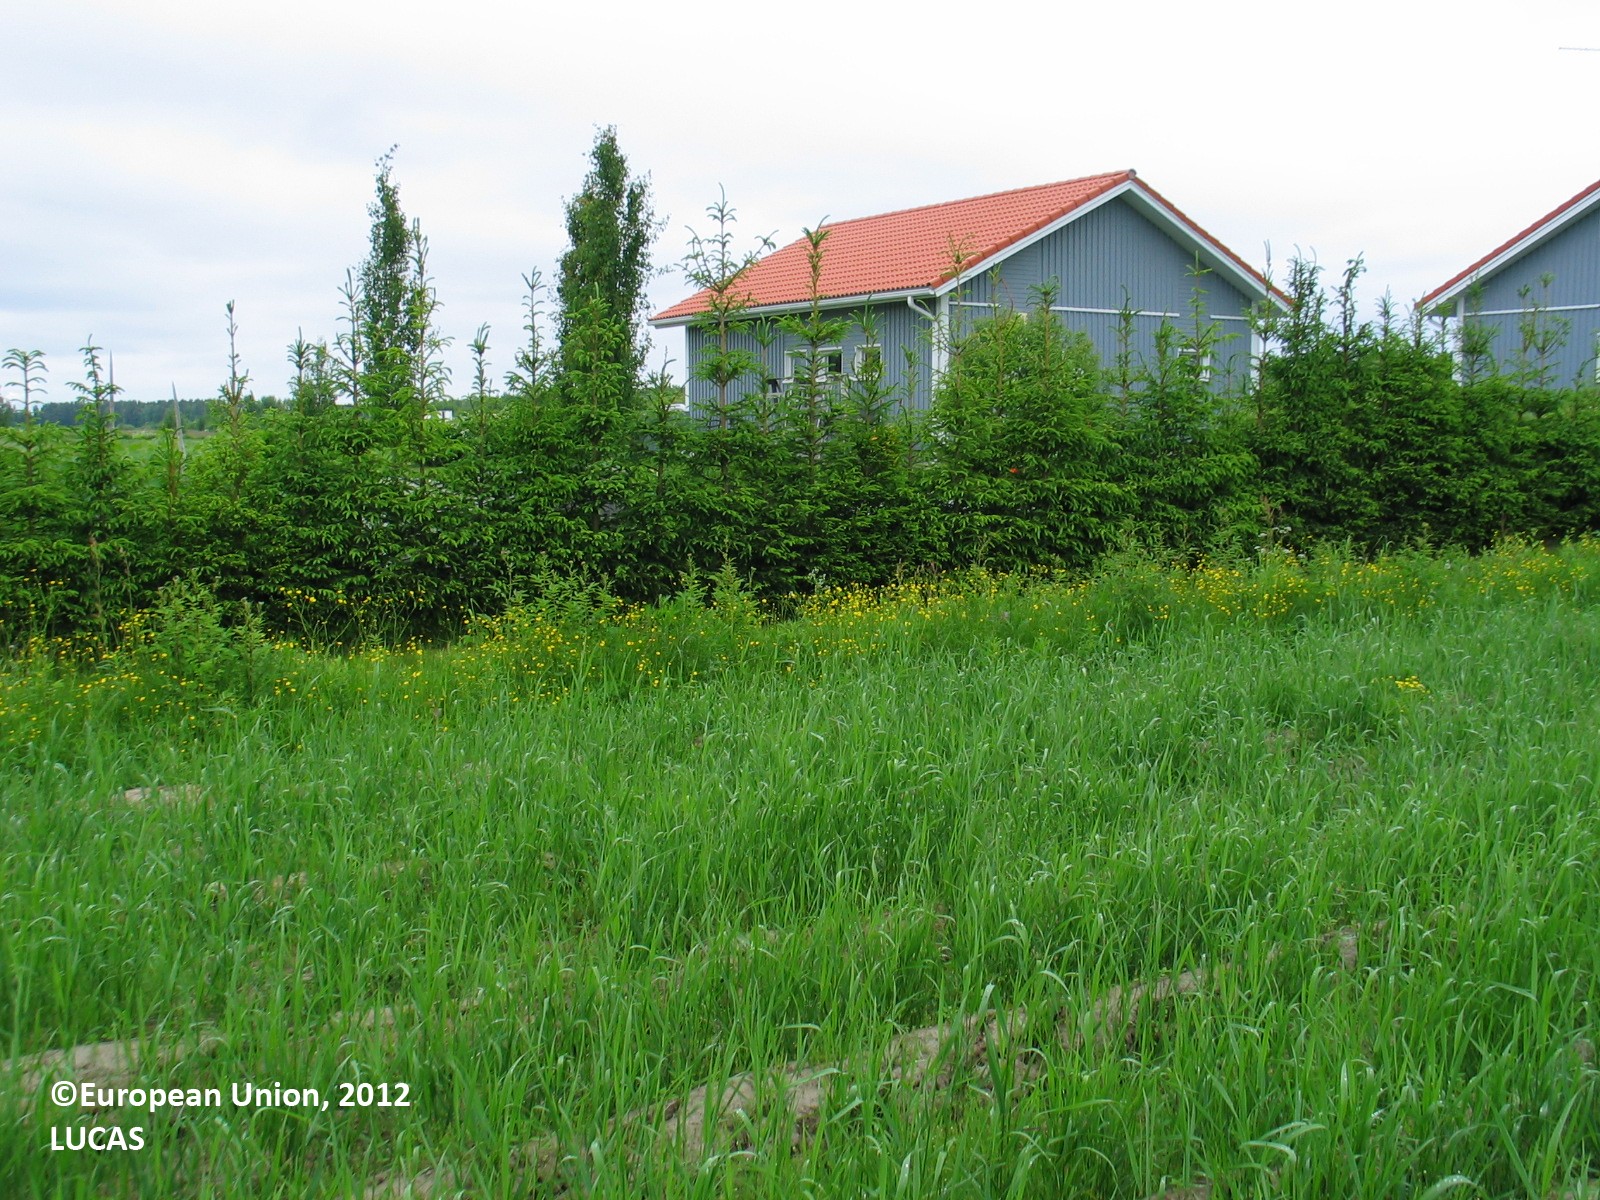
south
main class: Grassland
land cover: Grassland without tree/shrub cover
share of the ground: 25 - 50 %
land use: Agriculture (excluding fallow land and kitchen gardens)
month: June
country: FI
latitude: 65.1233
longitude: 25.3547
